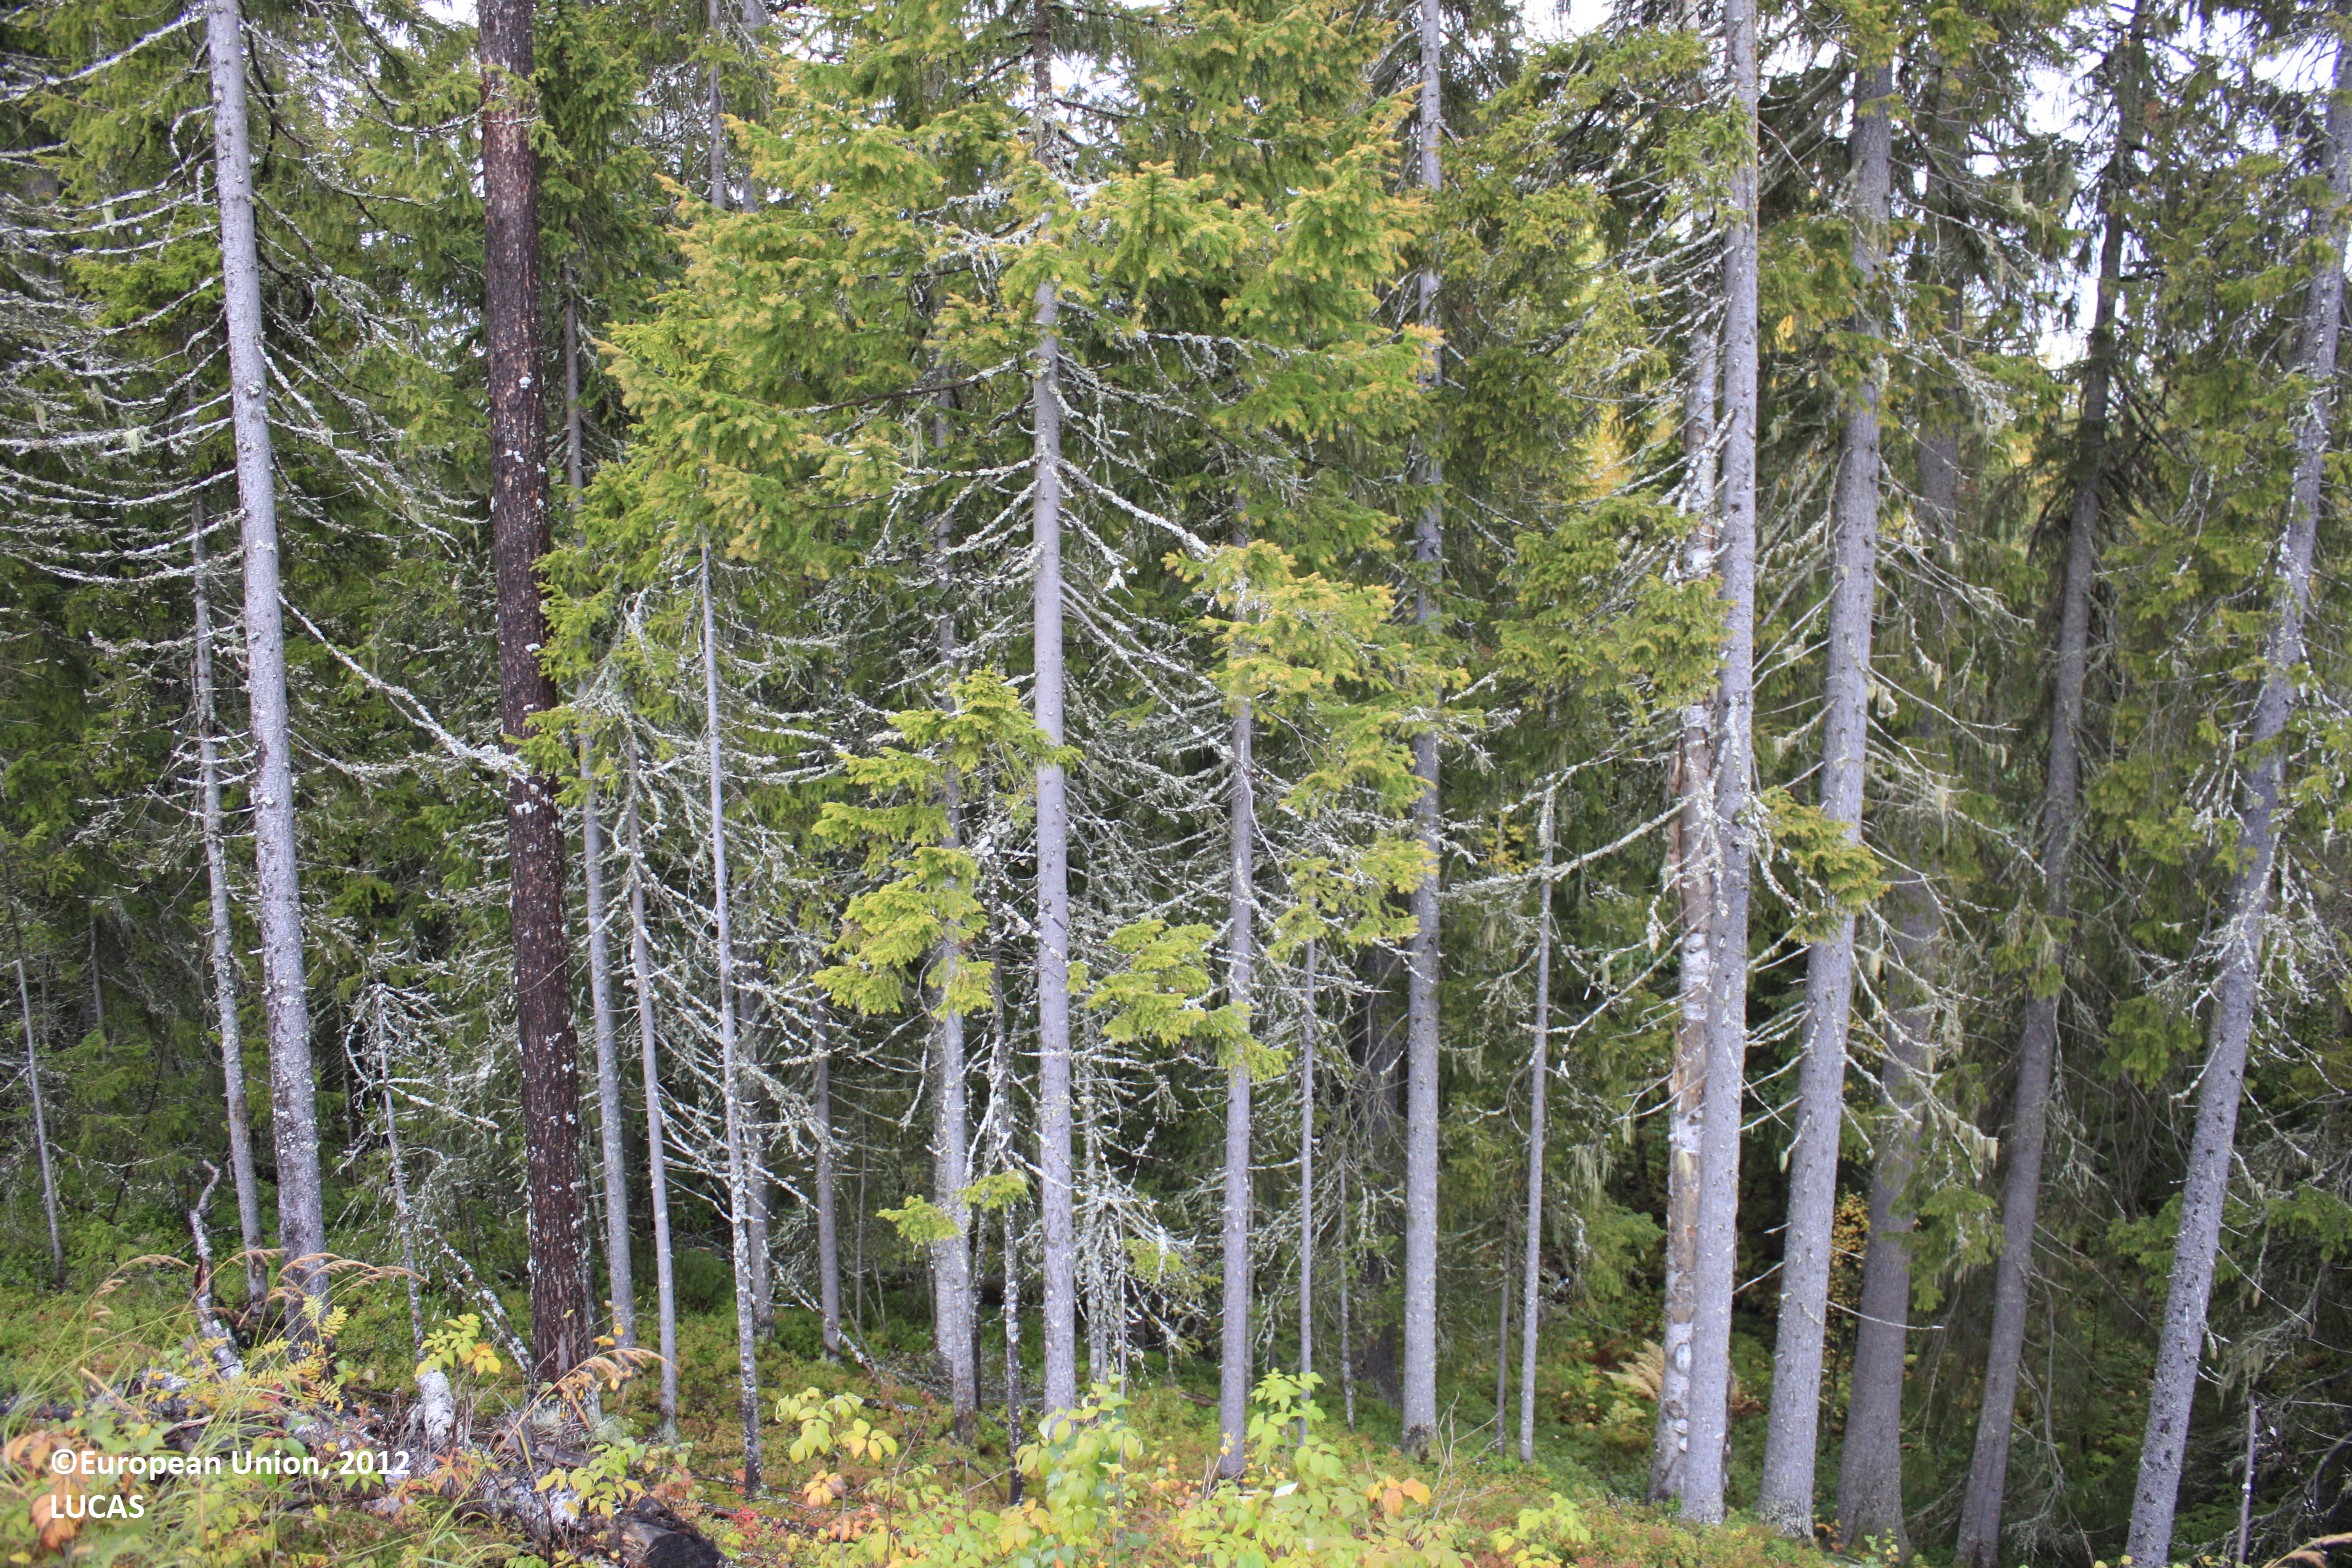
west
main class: Shrubland
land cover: Shrubland with sparse tree cover
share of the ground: > 75 %
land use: Forestry
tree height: < 5 m
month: September
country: FI
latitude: 65.6928
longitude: 27.4331
